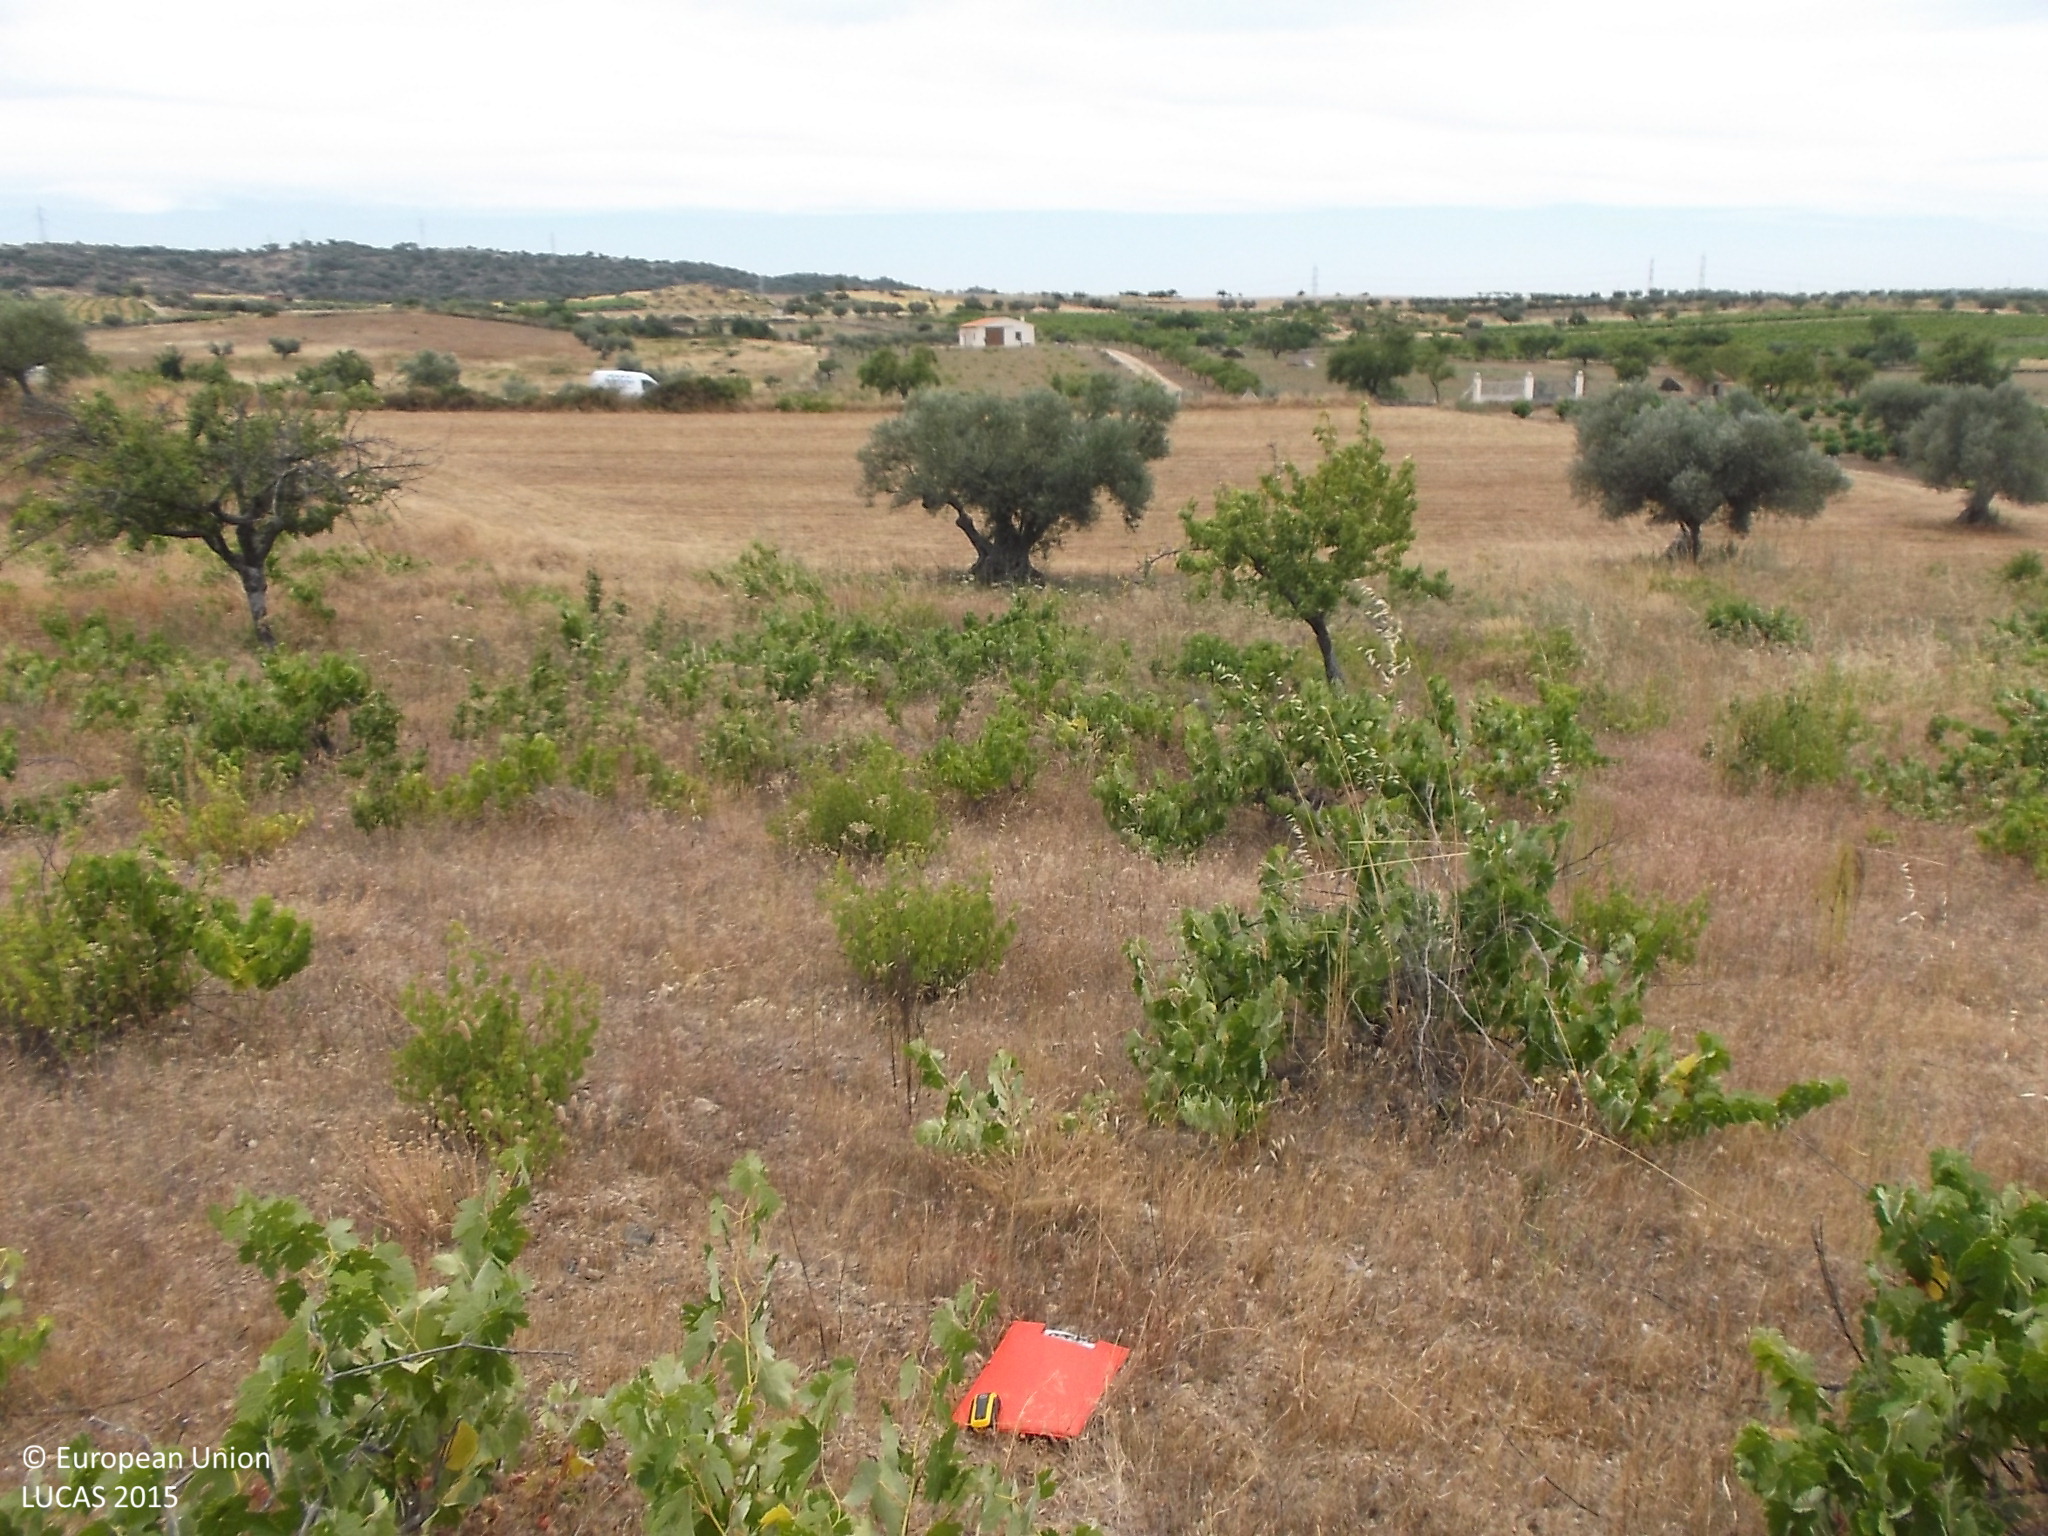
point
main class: Cropland
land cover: Vineyards
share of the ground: 10 - 25 %
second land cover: Spontaneously vegetated surfaces
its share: > 75 %
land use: Agriculture (excluding fallow land and kitchen gardens)
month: July
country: ES
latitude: 41.3064
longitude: -6.4012
